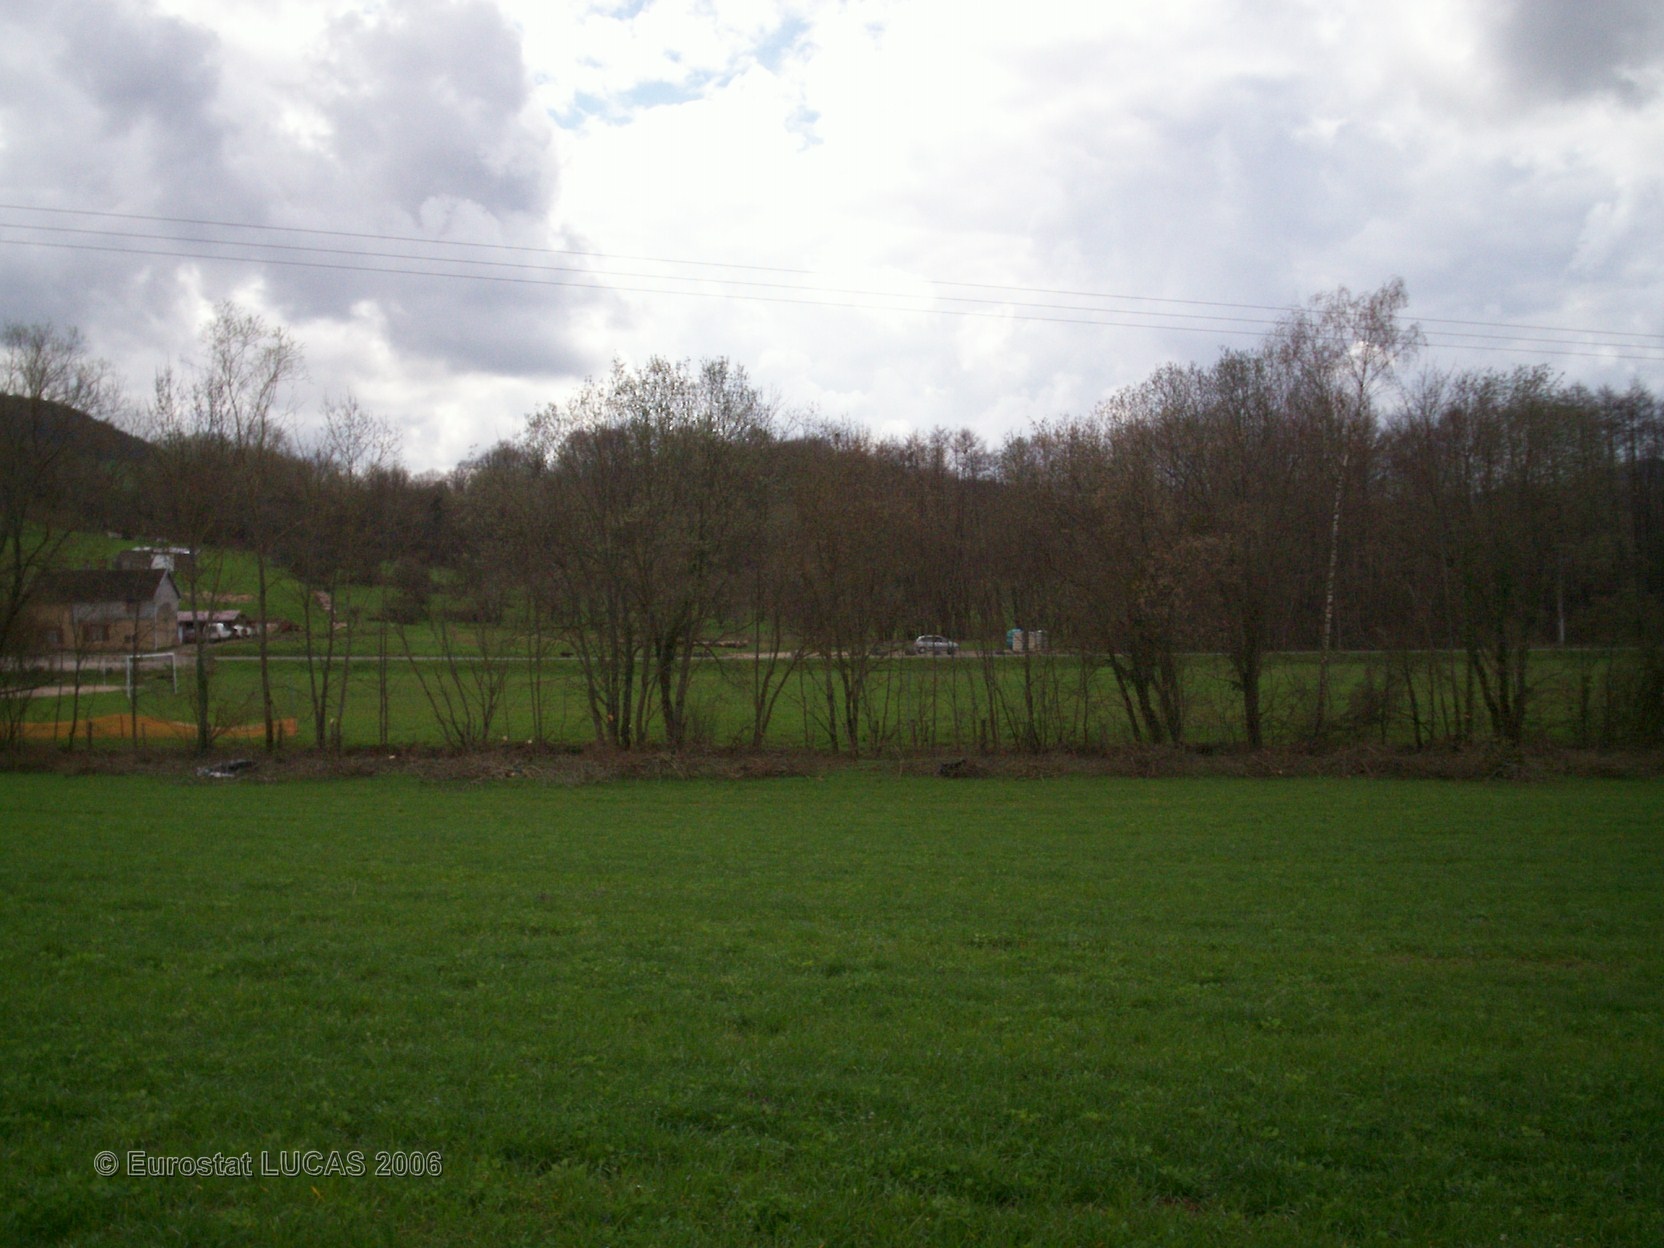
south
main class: Cropland
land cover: Other leguminous and mixtures for fodder
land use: Agriculture (excluding fallow land and kitchen gardens)
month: April
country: FR
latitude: 47.5206
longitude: 6.5354
